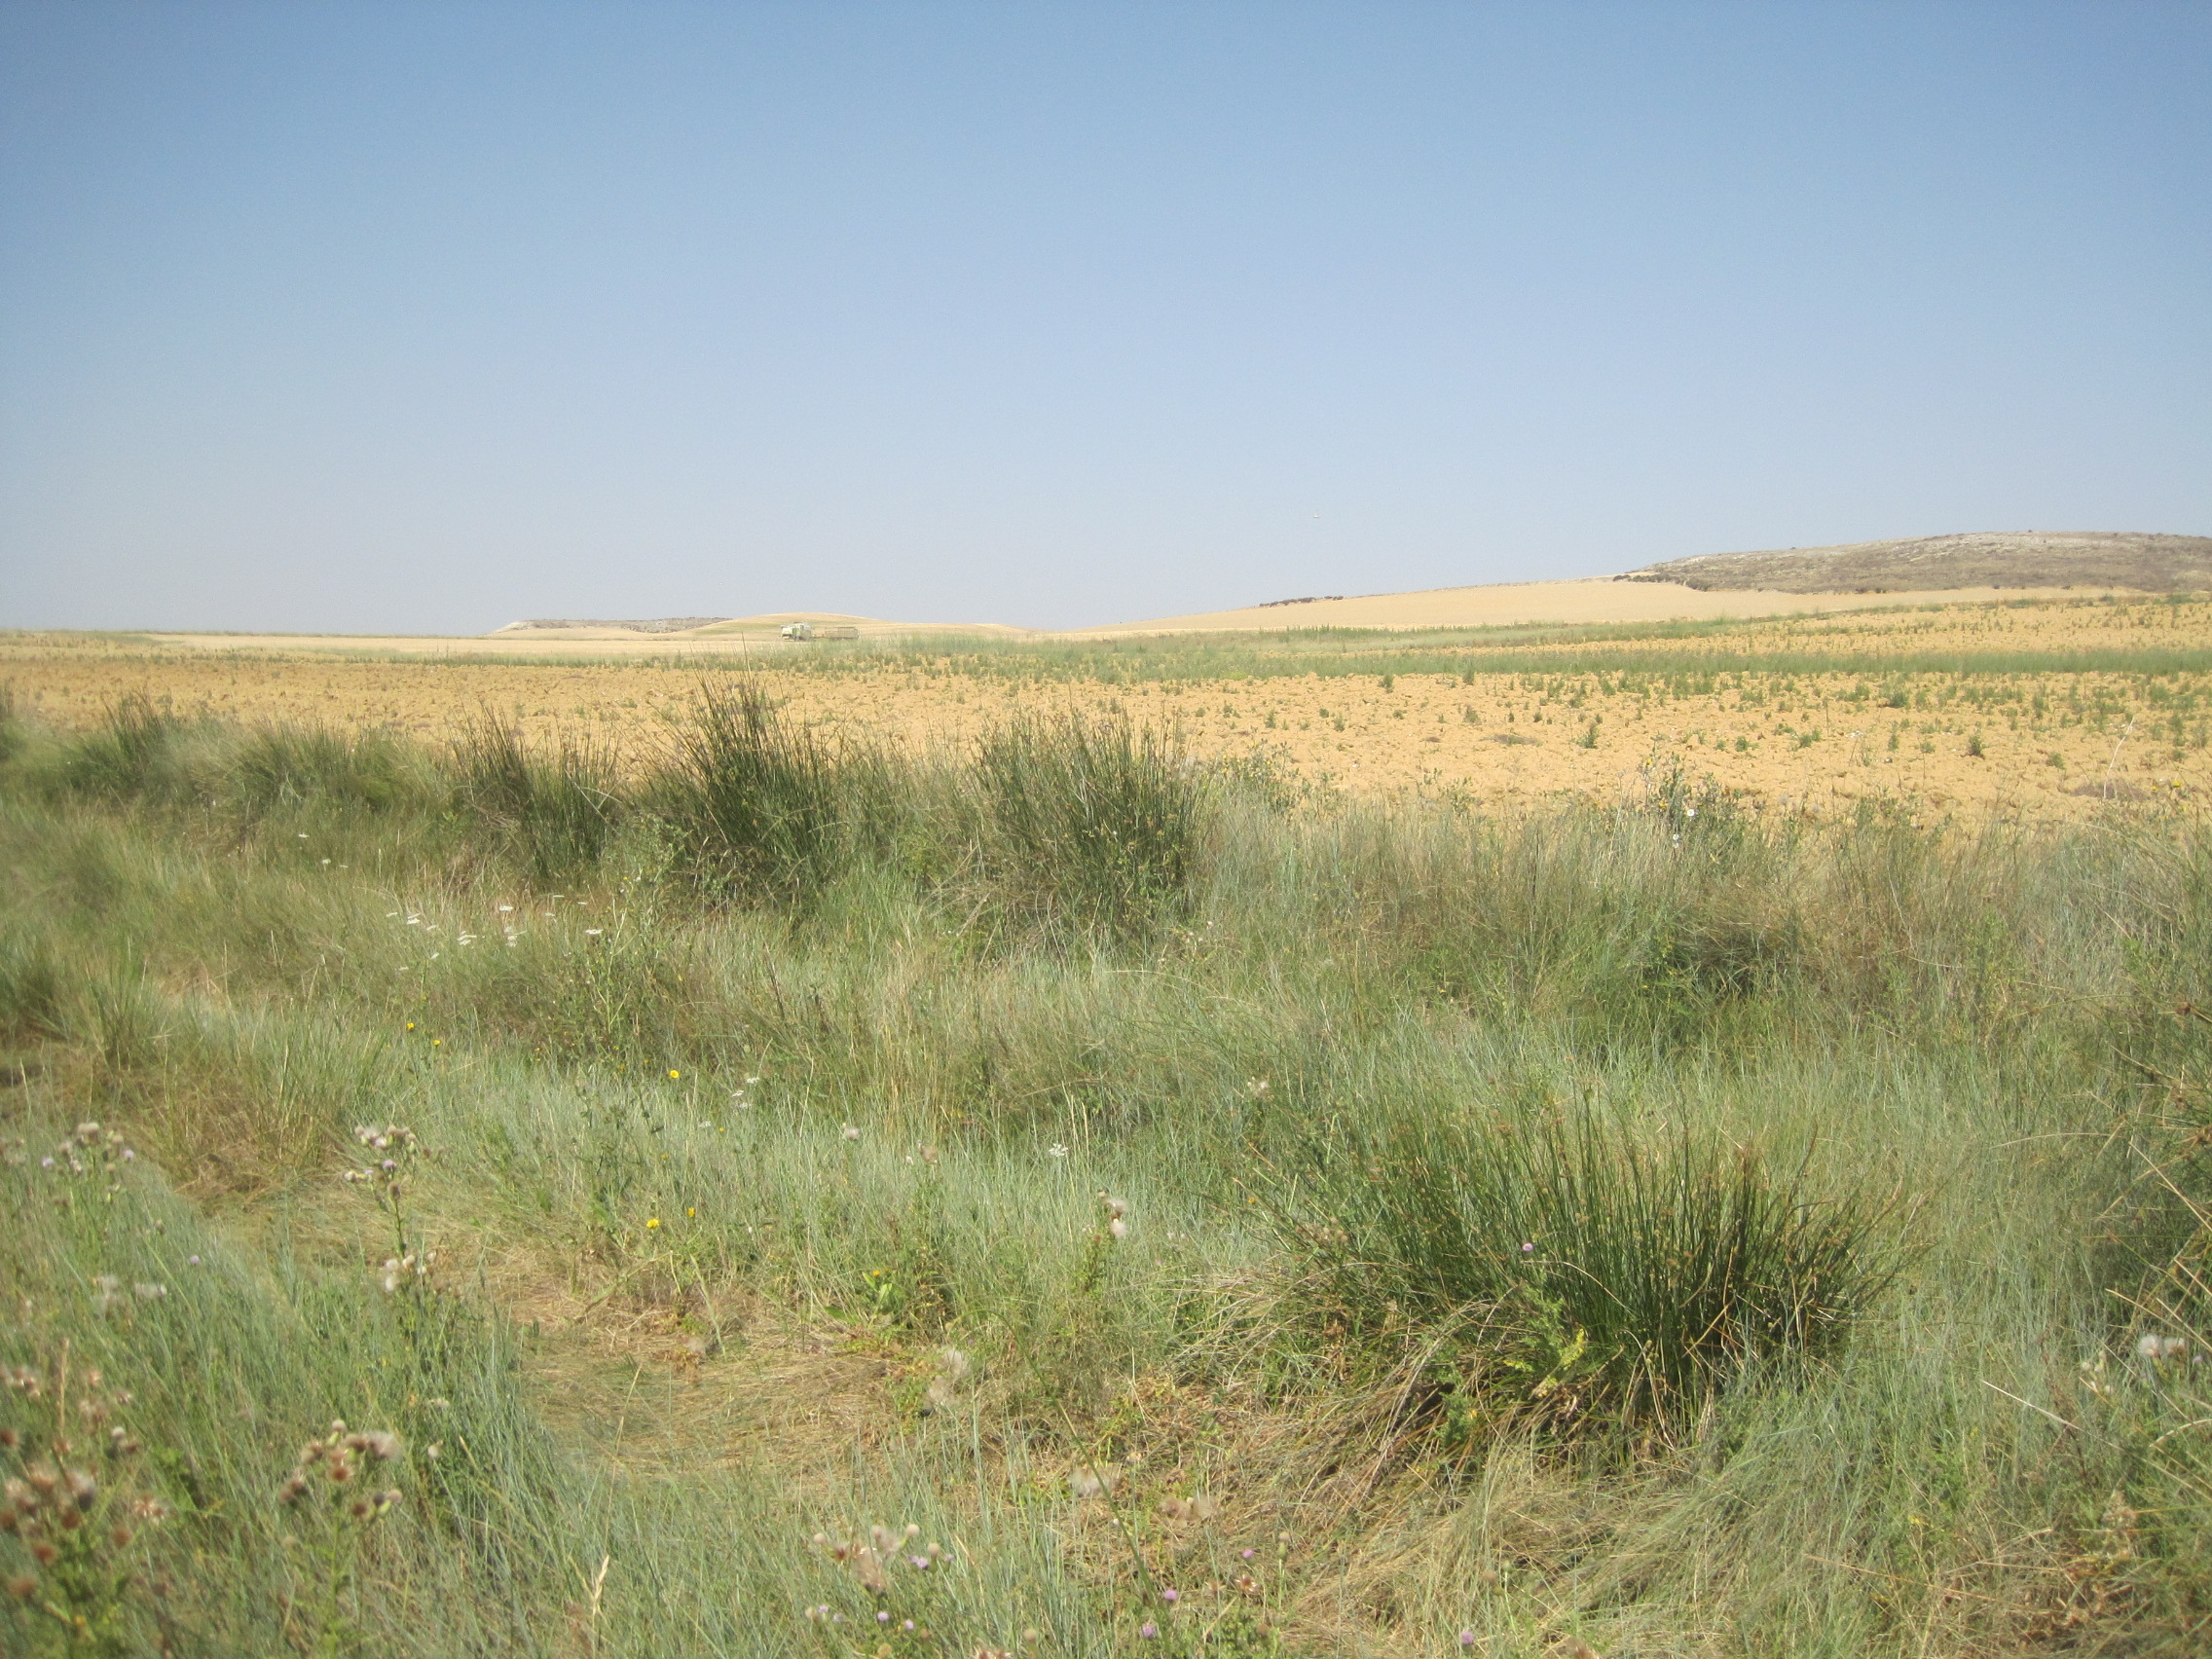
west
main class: Grassland
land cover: Grassland without tree/shrub cover
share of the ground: > 75 %
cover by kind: herbaceous plants 100 %
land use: Abandoned areas
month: July
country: ES
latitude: 41.6140
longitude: -5.4059
